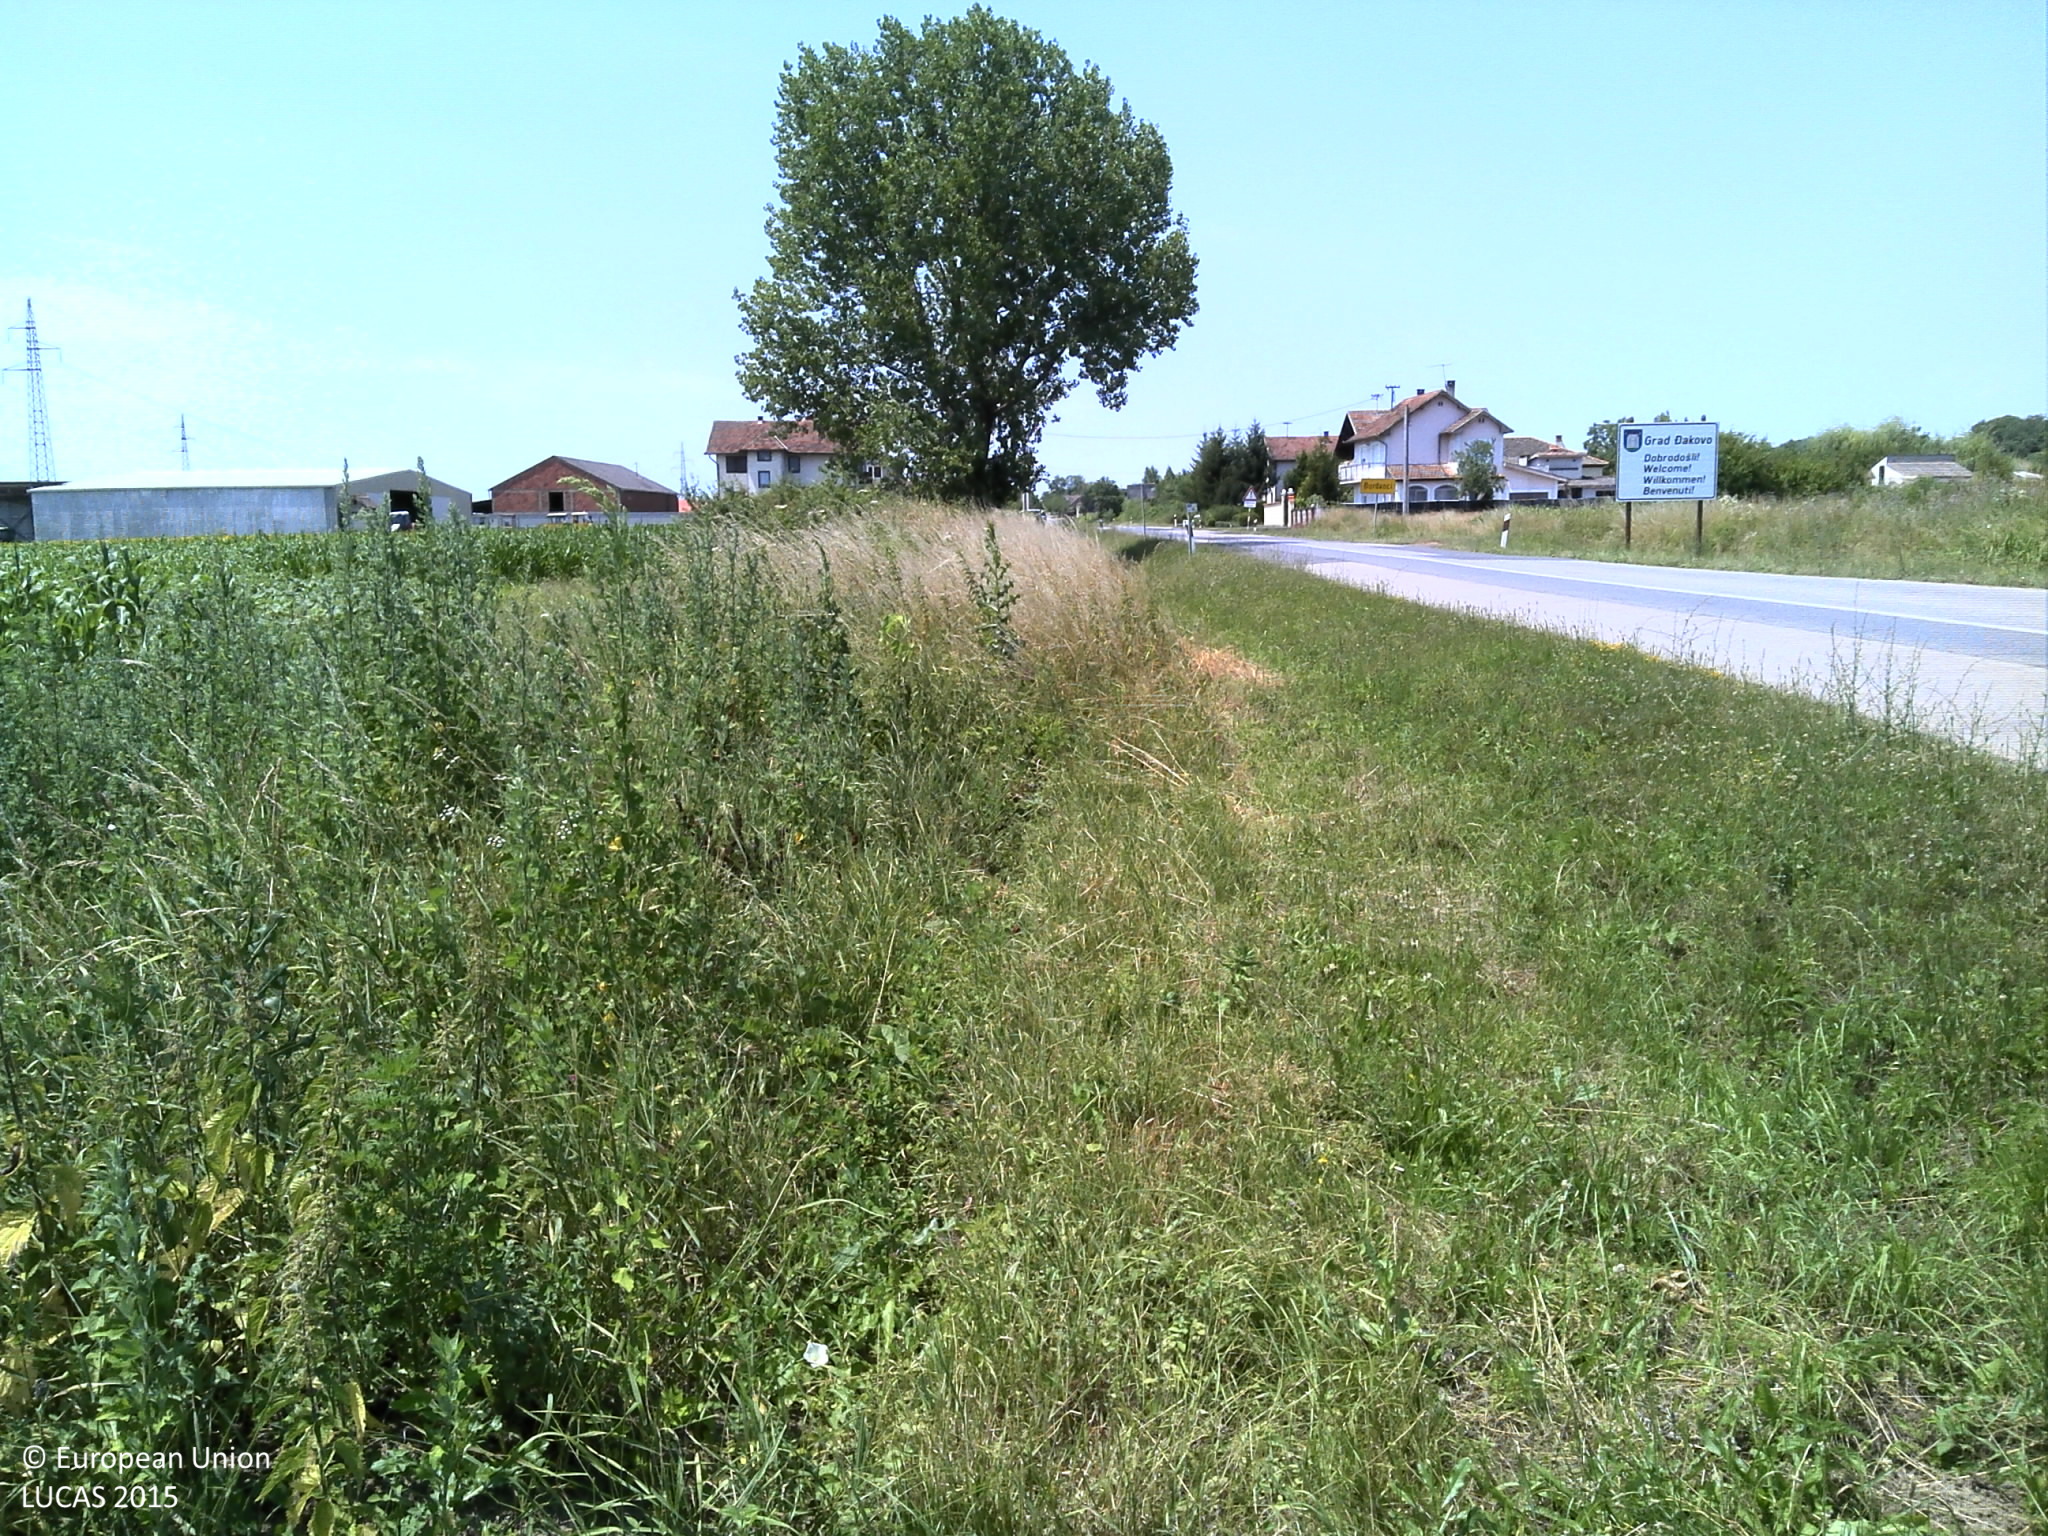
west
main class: Grassland
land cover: Grassland without tree/shrub cover
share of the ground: > 75 %
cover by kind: herbaceous plants 100 %
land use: Semi-natural and natural areas not in use
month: July
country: HR
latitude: 45.2872
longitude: 18.5096
